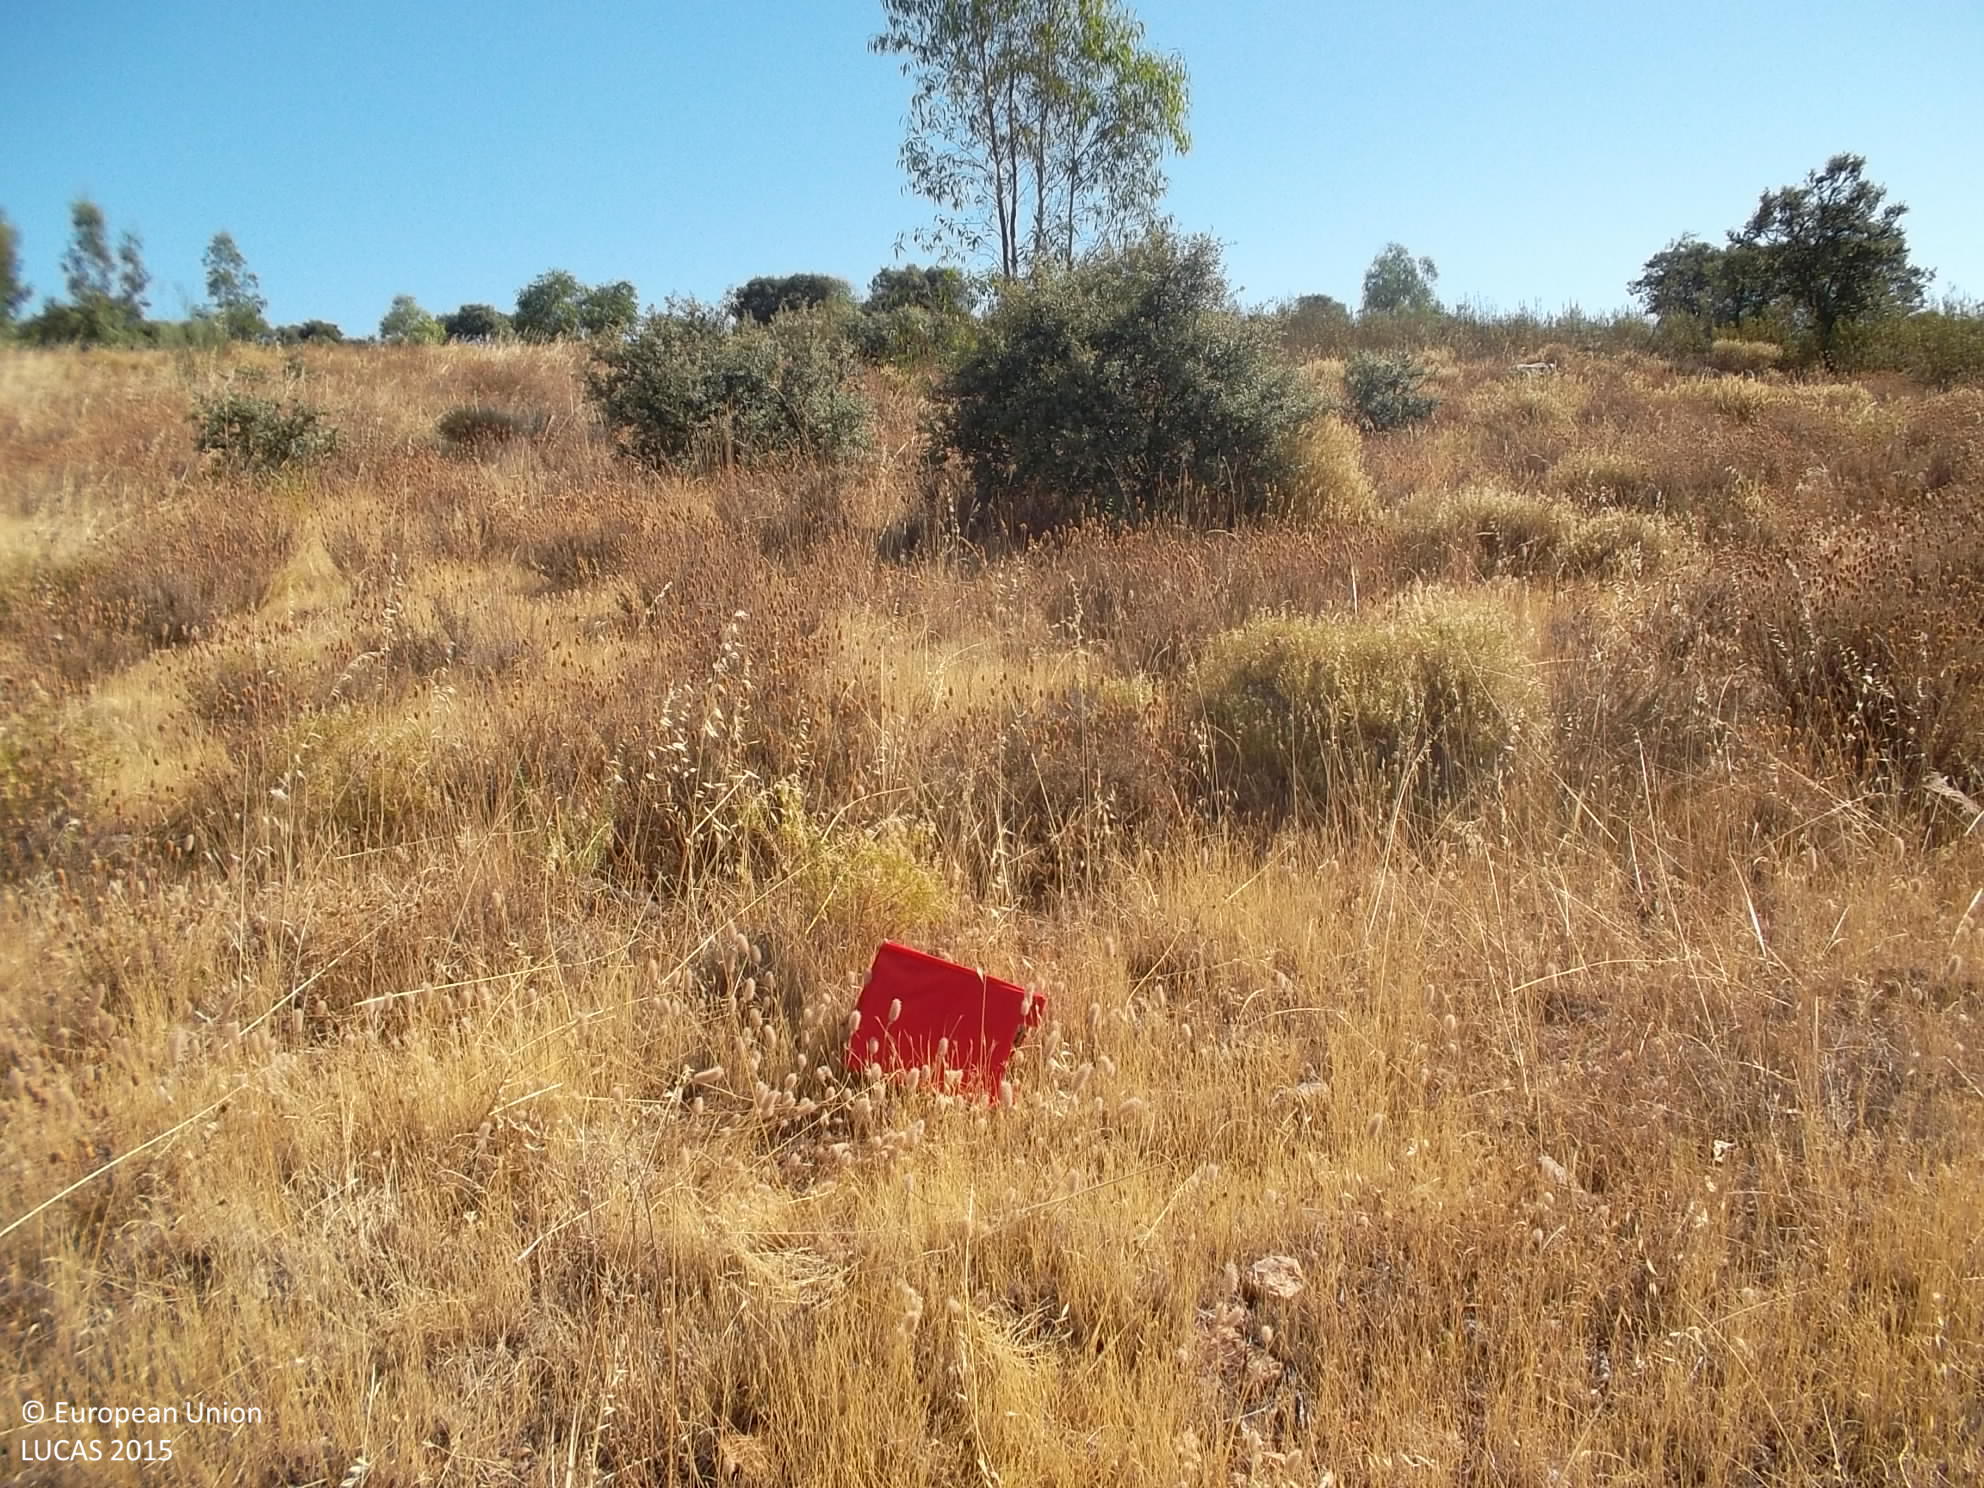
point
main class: Shrubland
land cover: Shrubland with sparse tree cover
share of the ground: > 75 %
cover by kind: shrubs 50 %, herbaceous plants 45 %, broadleaved forest trees 5 %
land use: Semi-natural and natural areas not in use
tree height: < 5 m
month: July
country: ES
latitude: 38.4769
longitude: -5.8247
